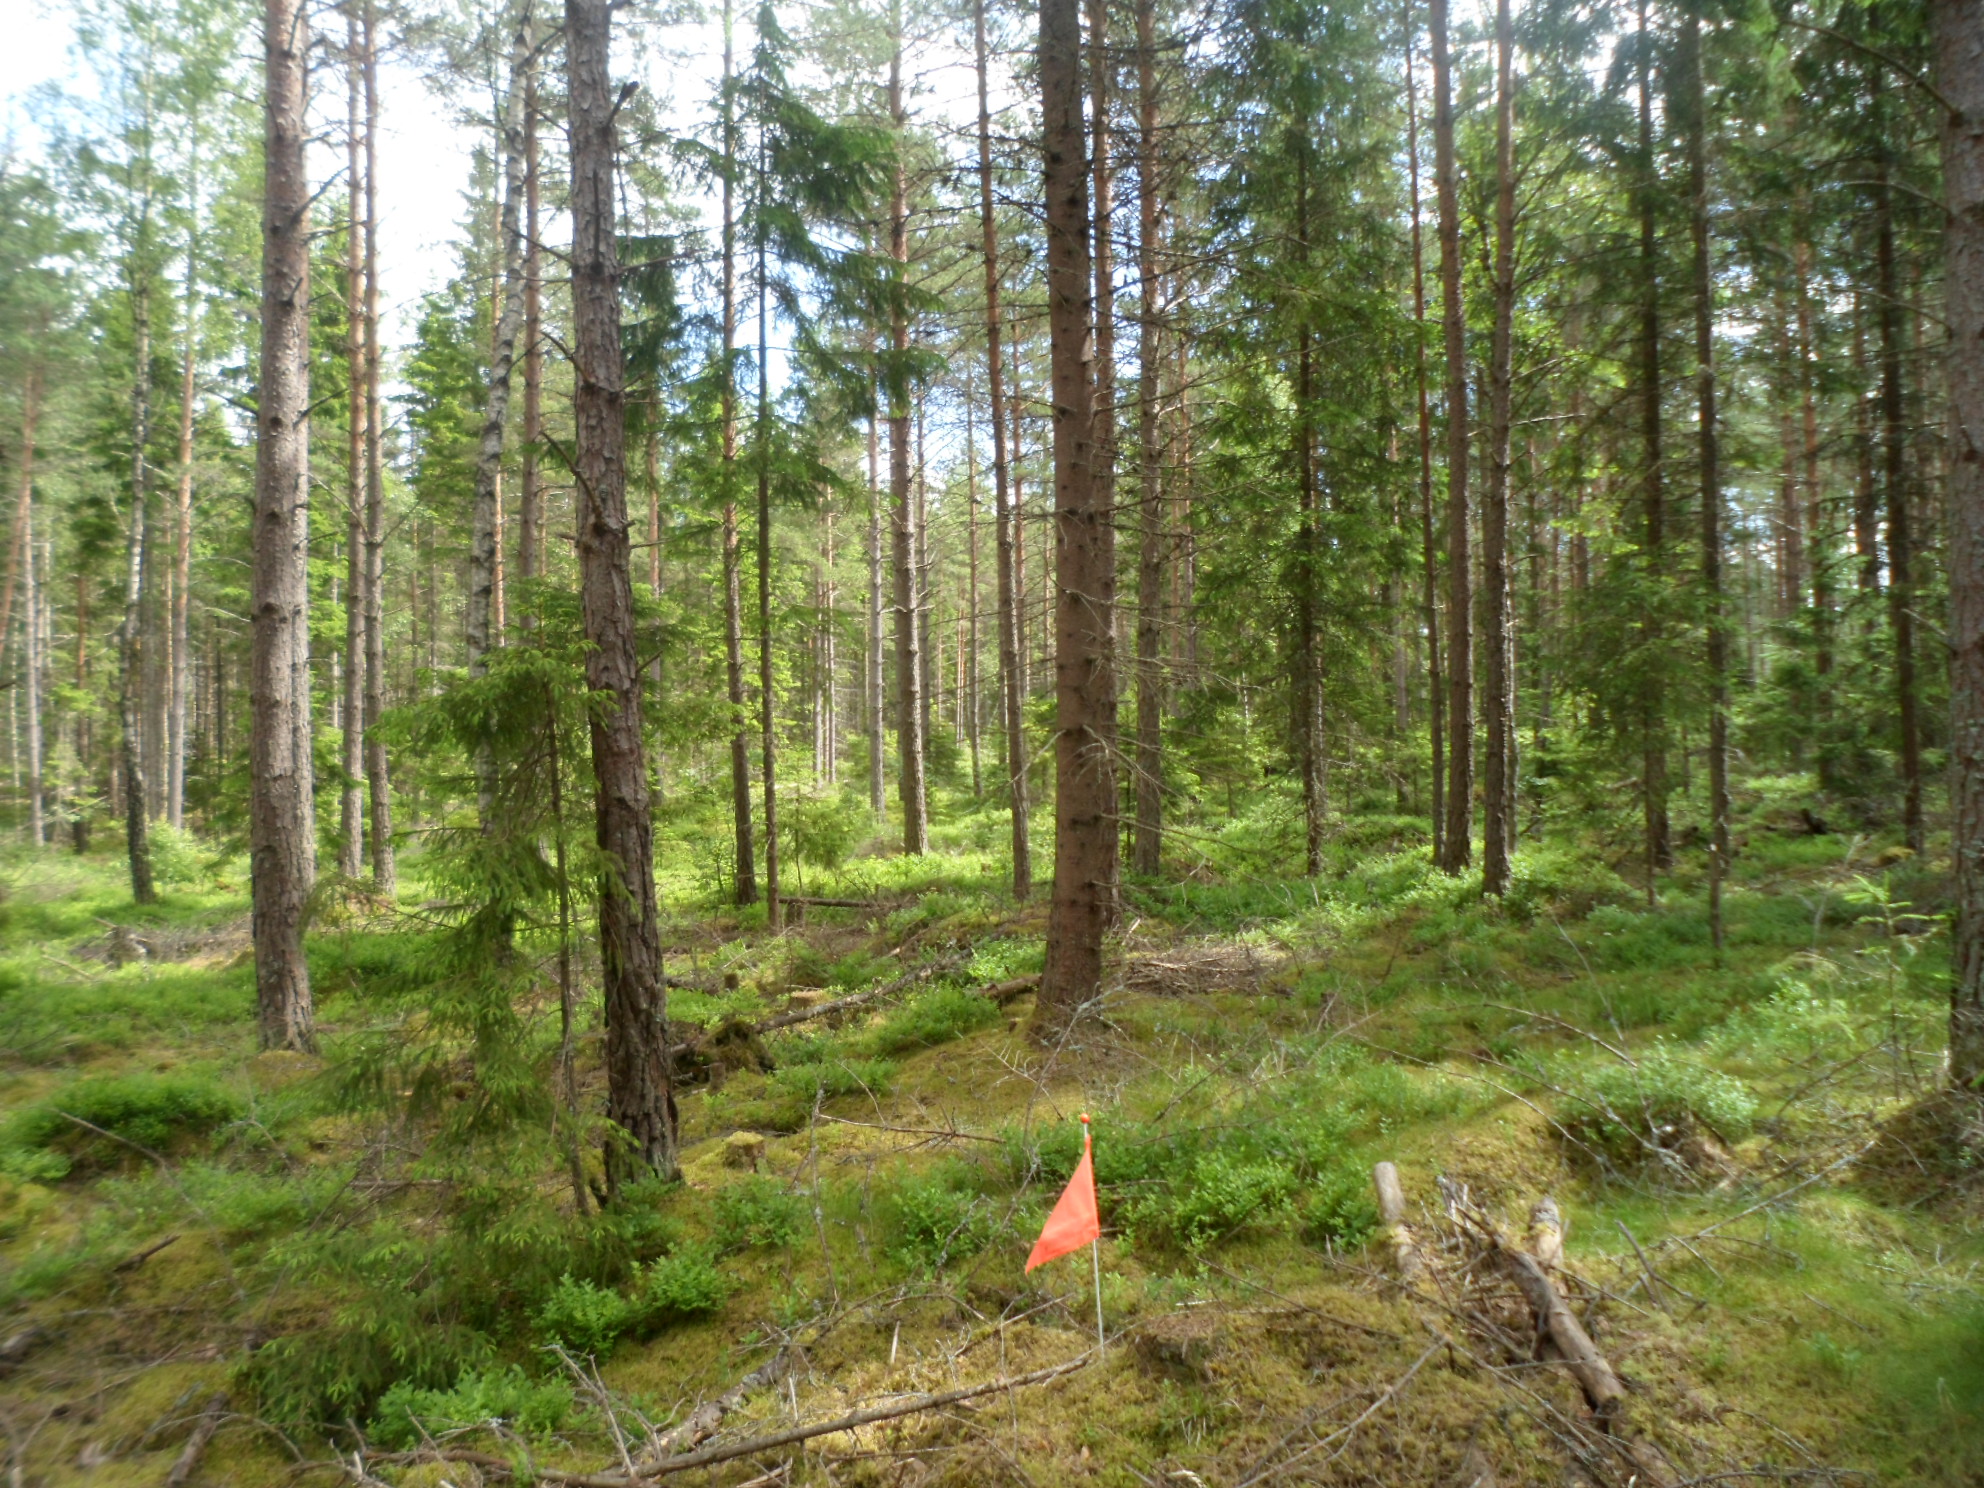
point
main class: Woodland
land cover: Pine dominated coniferous woodland
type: boreal forest
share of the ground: 50 - 75 %
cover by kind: coniferous forest trees 55 %, lichens and mosses 20 %, shrubs 15 %, herbaceous plants 10 %
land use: Forestry
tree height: > 5 m
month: June
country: SE
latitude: 57.1606
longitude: 14.8080
